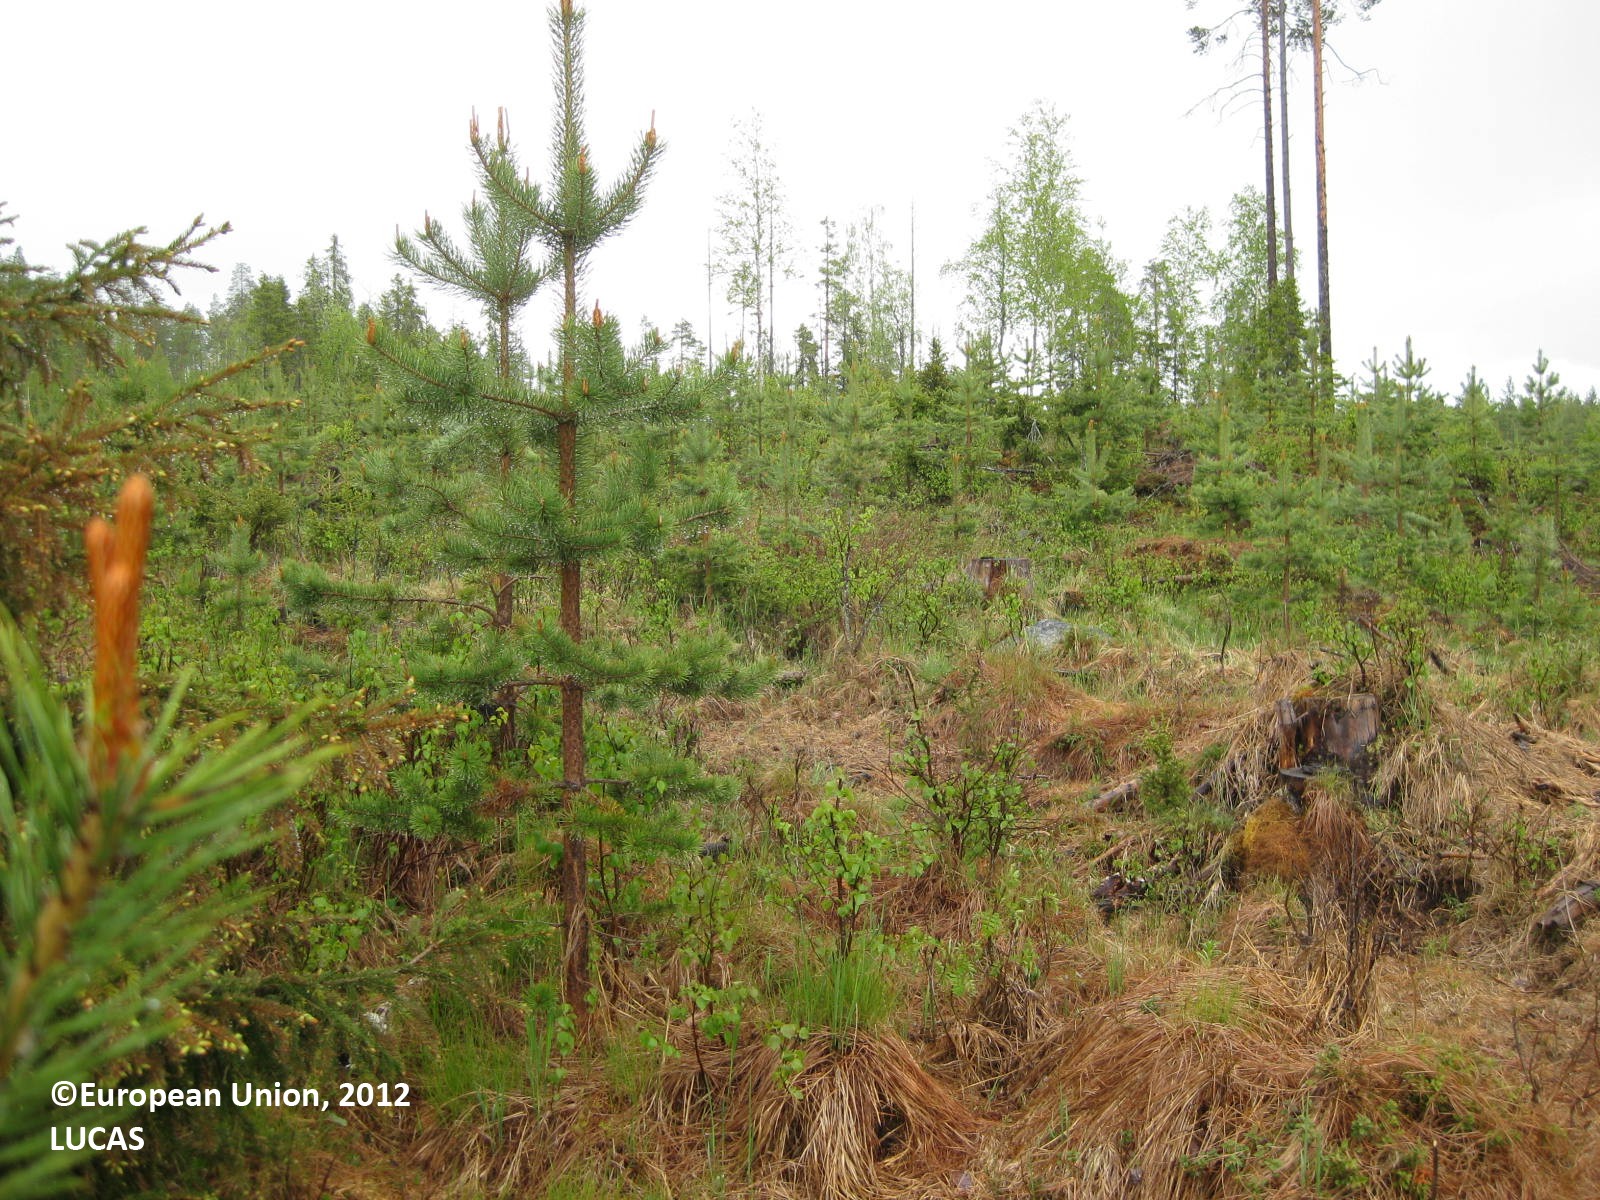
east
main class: Woodland
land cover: Pine dominated coniferous woodland
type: boreal forest
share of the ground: 50 - 75 %
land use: Forestry
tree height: < 5 m
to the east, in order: Pine dominated coniferous woodland; Pine dominated mixed woodland; Ditches and canals; Pine dominated mixed woodland
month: June
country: FI
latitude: 65.1945
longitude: 29.4927
